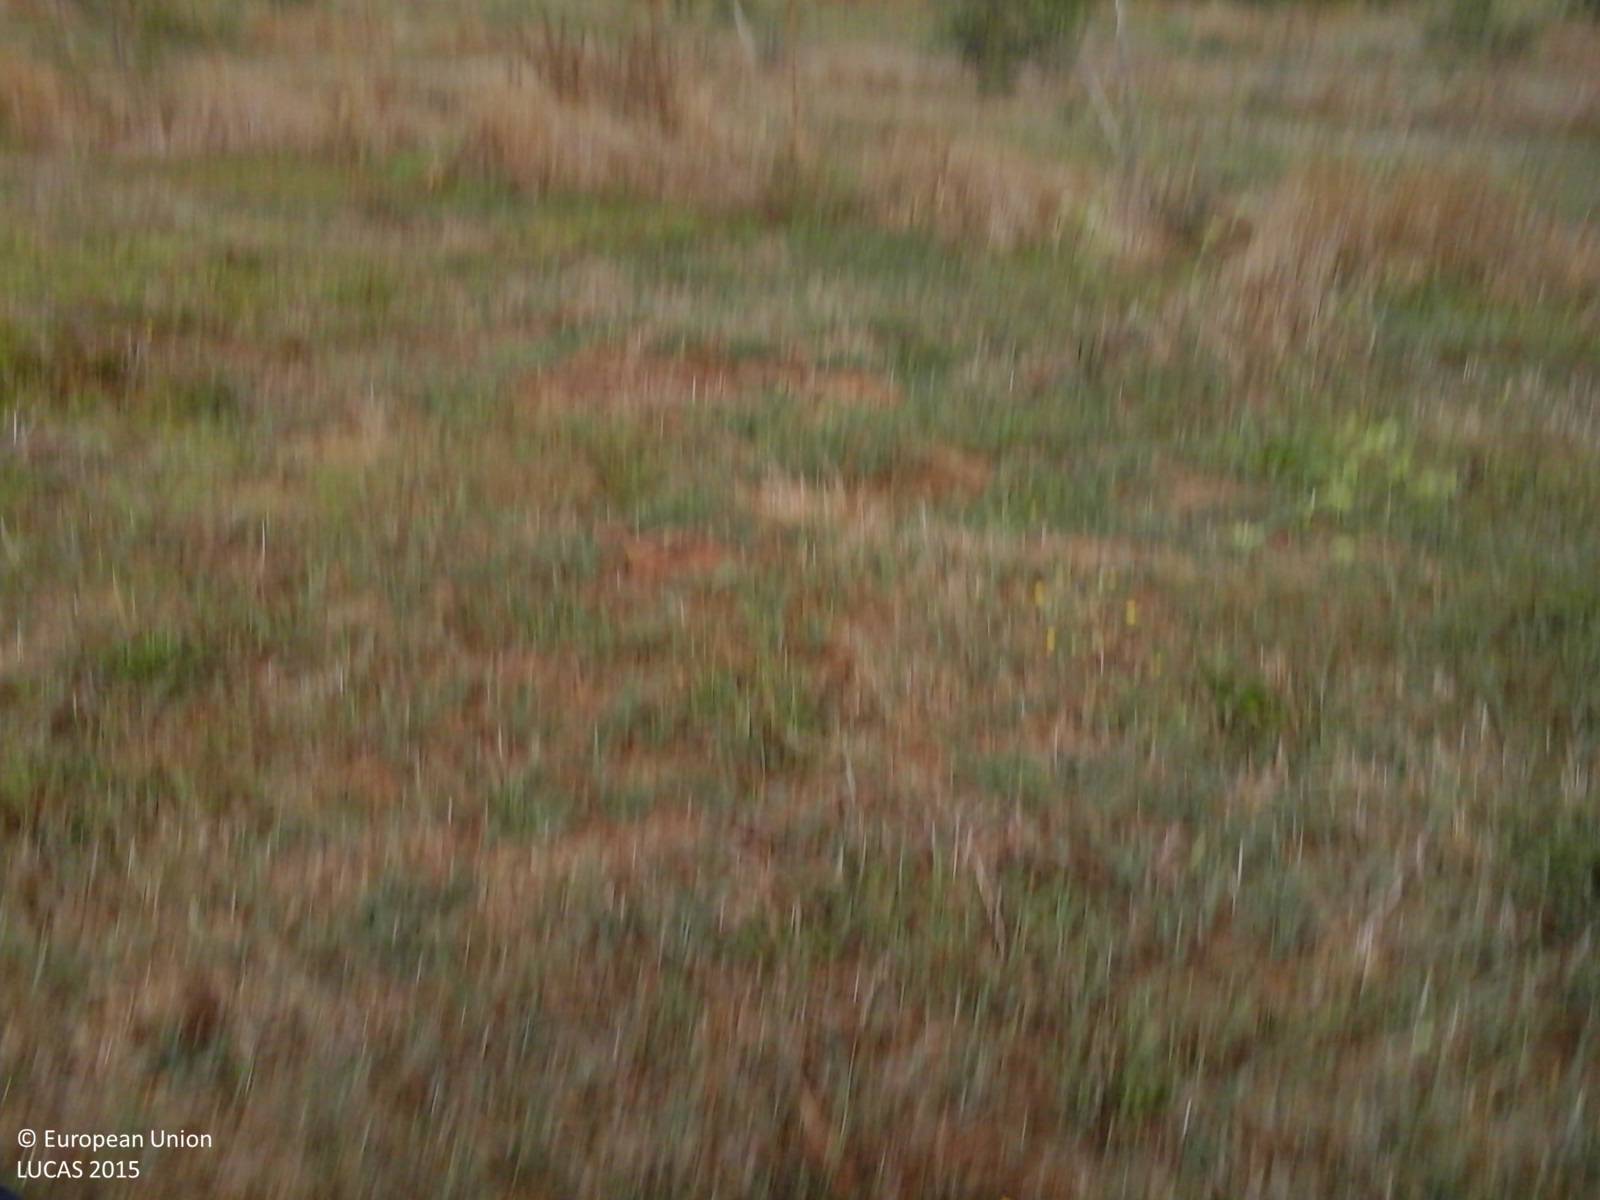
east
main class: Cropland
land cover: Olive groves
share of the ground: 10 - 25 %
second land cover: Grassland without tree/shrub cover
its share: > 75 %
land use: Agriculture (excluding fallow land and kitchen gardens)
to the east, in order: Olive groves; Grassland without tree/shrub cover; Dry stone walls; Single bushes/trees; Grassland without tree/shrub cover; Dry stone walls; Abandoned hedges; Grassland with sparse tree/shrub cover
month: September
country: IT
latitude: 40.2575
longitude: 8.6081
